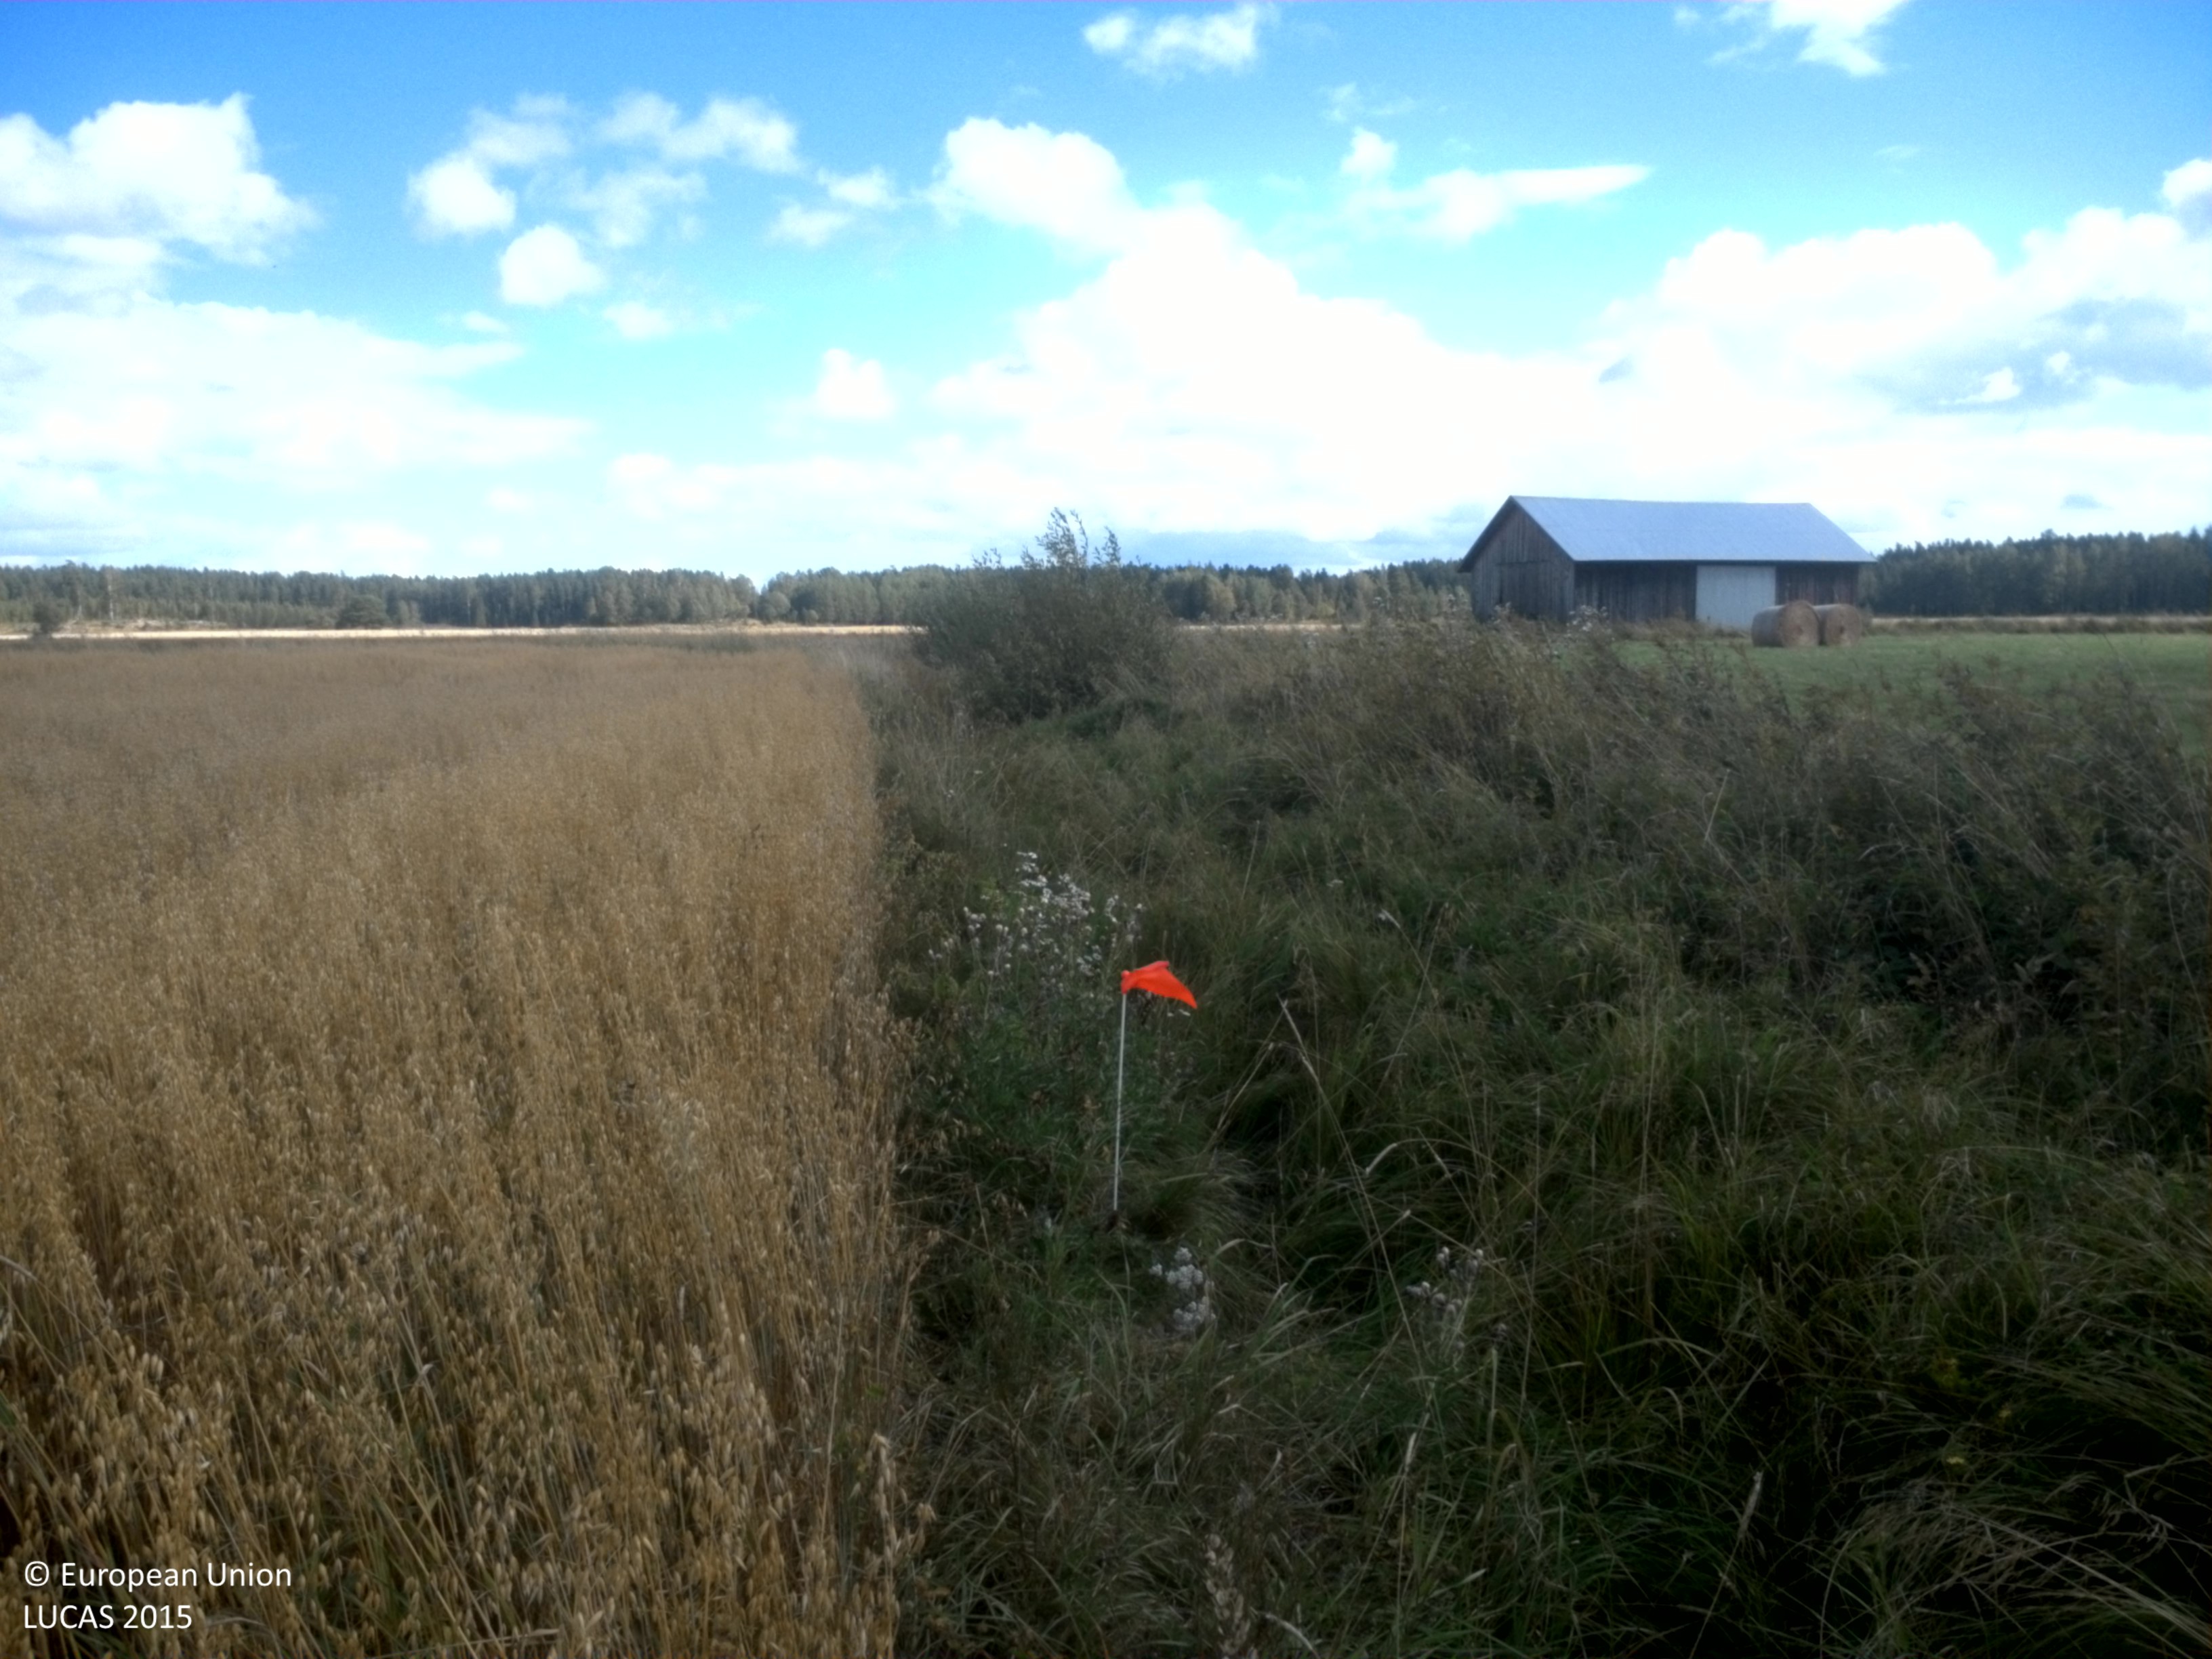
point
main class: Cropland
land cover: Oats
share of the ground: > 75 %
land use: Agriculture (excluding fallow land and kitchen gardens)
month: August
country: SE
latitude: 59.4702
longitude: 15.6919
